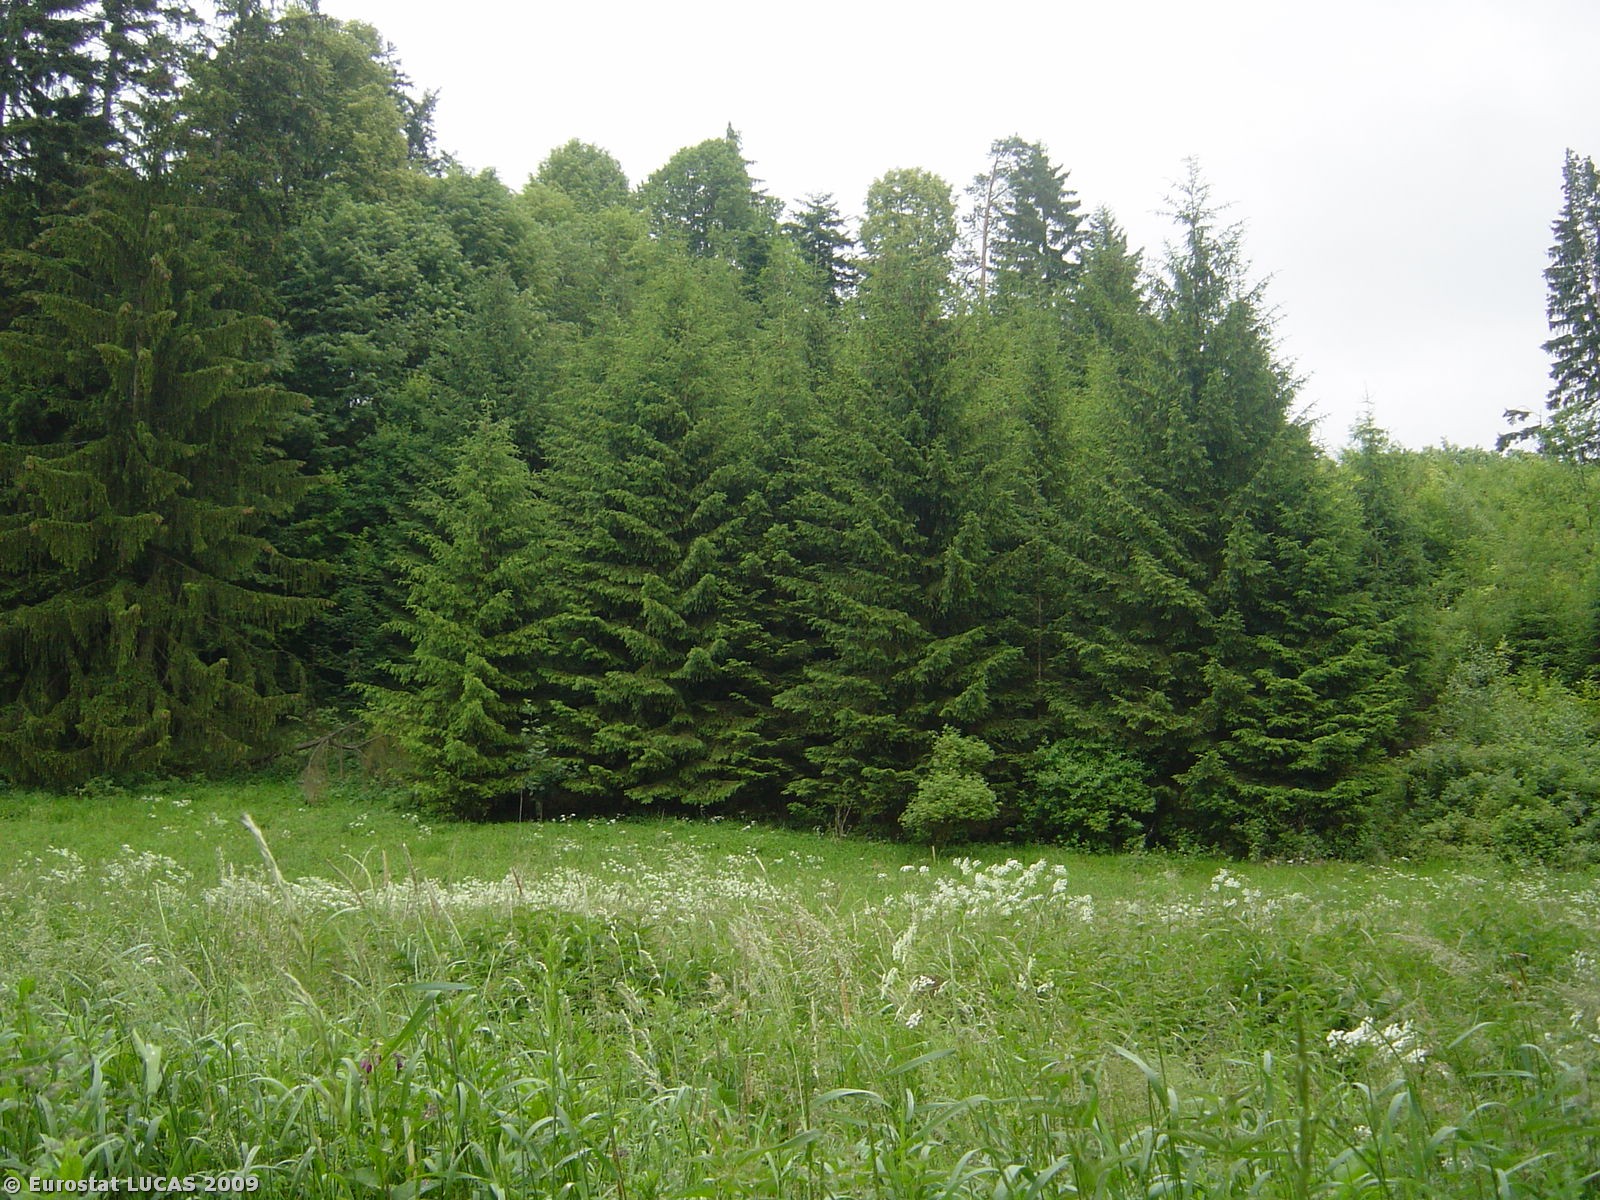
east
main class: Grassland
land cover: Grassland without tree/shrub cover
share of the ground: > 75 %
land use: Unused
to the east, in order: Grassland without tree/shrub cover; Ditches and canals; Grassland without tree/shrub cover; Mixed woodland; Broadleaved woodland; Groves; Rape and turnip rape
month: June
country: CZ
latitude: 49.7273
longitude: 16.5136
